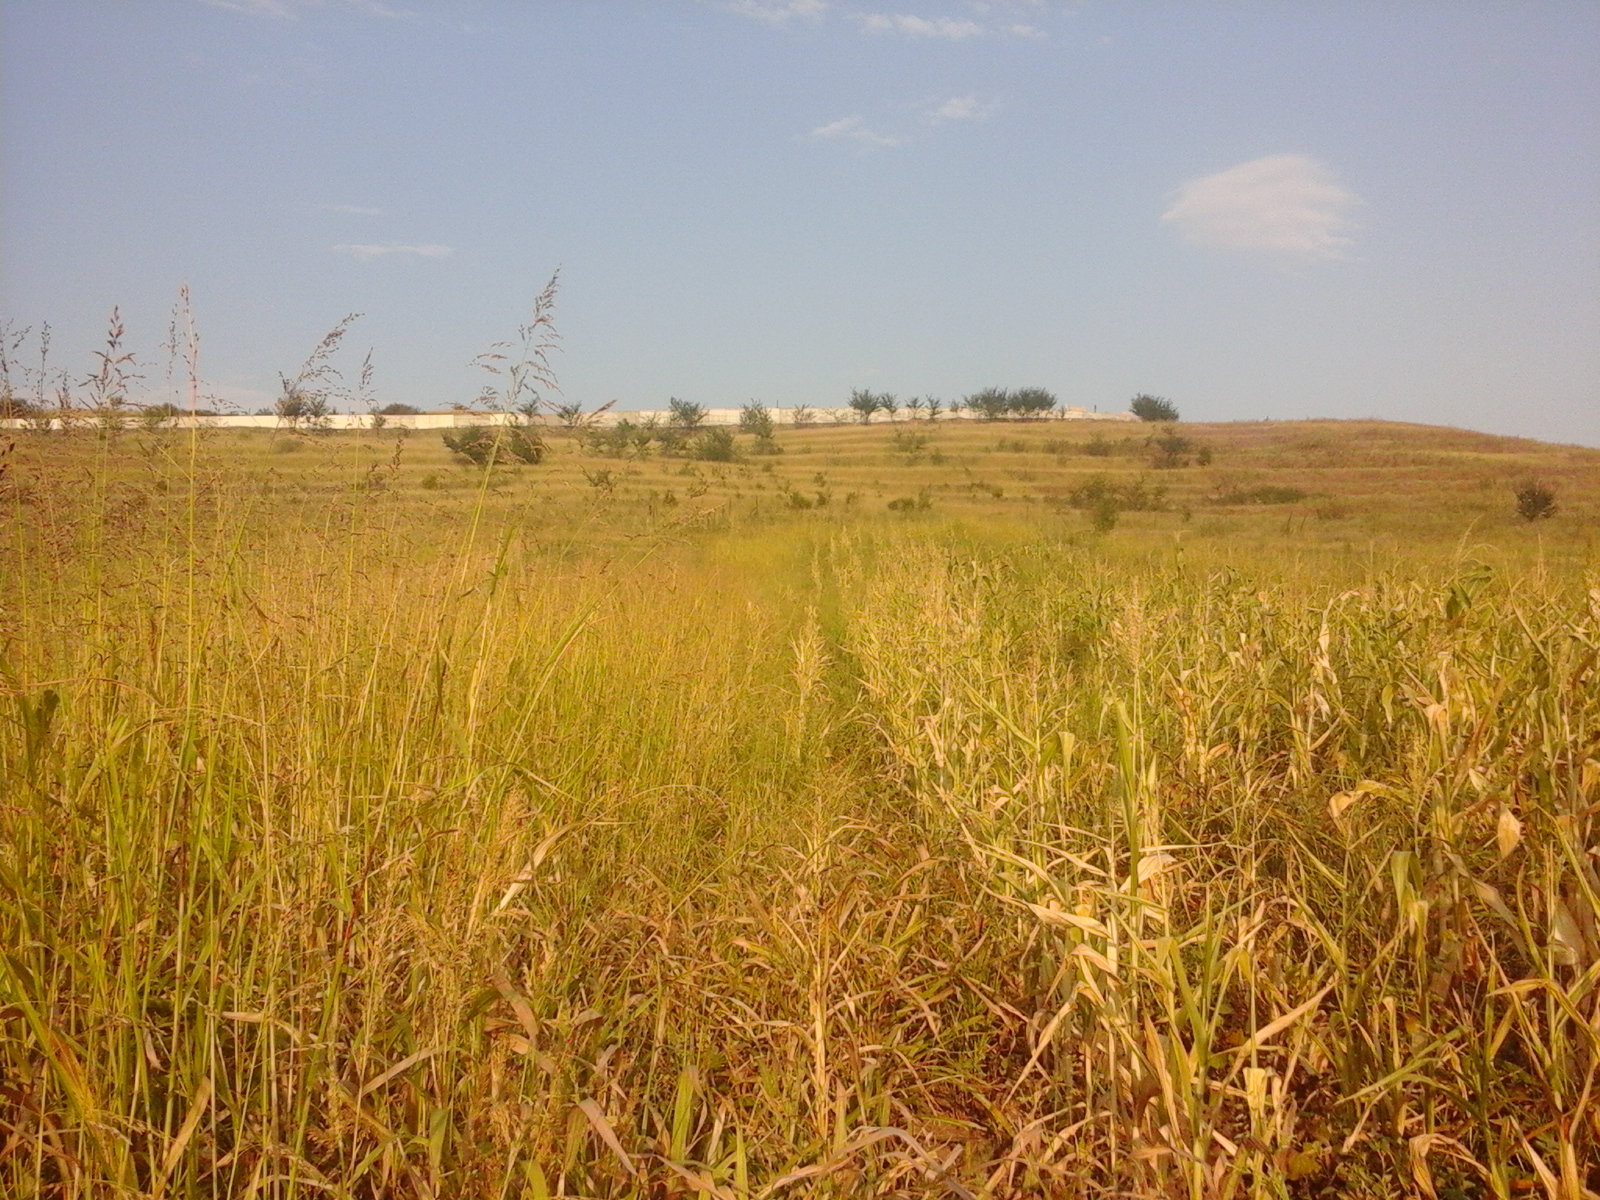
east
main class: Cropland
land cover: Maize
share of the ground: > 75 %
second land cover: Spontaneously vegetated surfaces
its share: 50 - 75 %
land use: Agriculture (excluding fallow land and kitchen gardens)
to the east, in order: Maize; Spontaneously vegetated surfaces; Tracks; Spontaneously vegetated surfaces; Grassland with sparse tree/shrub cover; Grassland without tree/shrub cover; Lines of trees; Spontaneously vegetated surfaces; Paved roads, cycling and walking lanes; Grass margins; Ditches and canals; Spontaneously vegetated surfaces
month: August
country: RO
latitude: 44.1603
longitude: 23.6199
